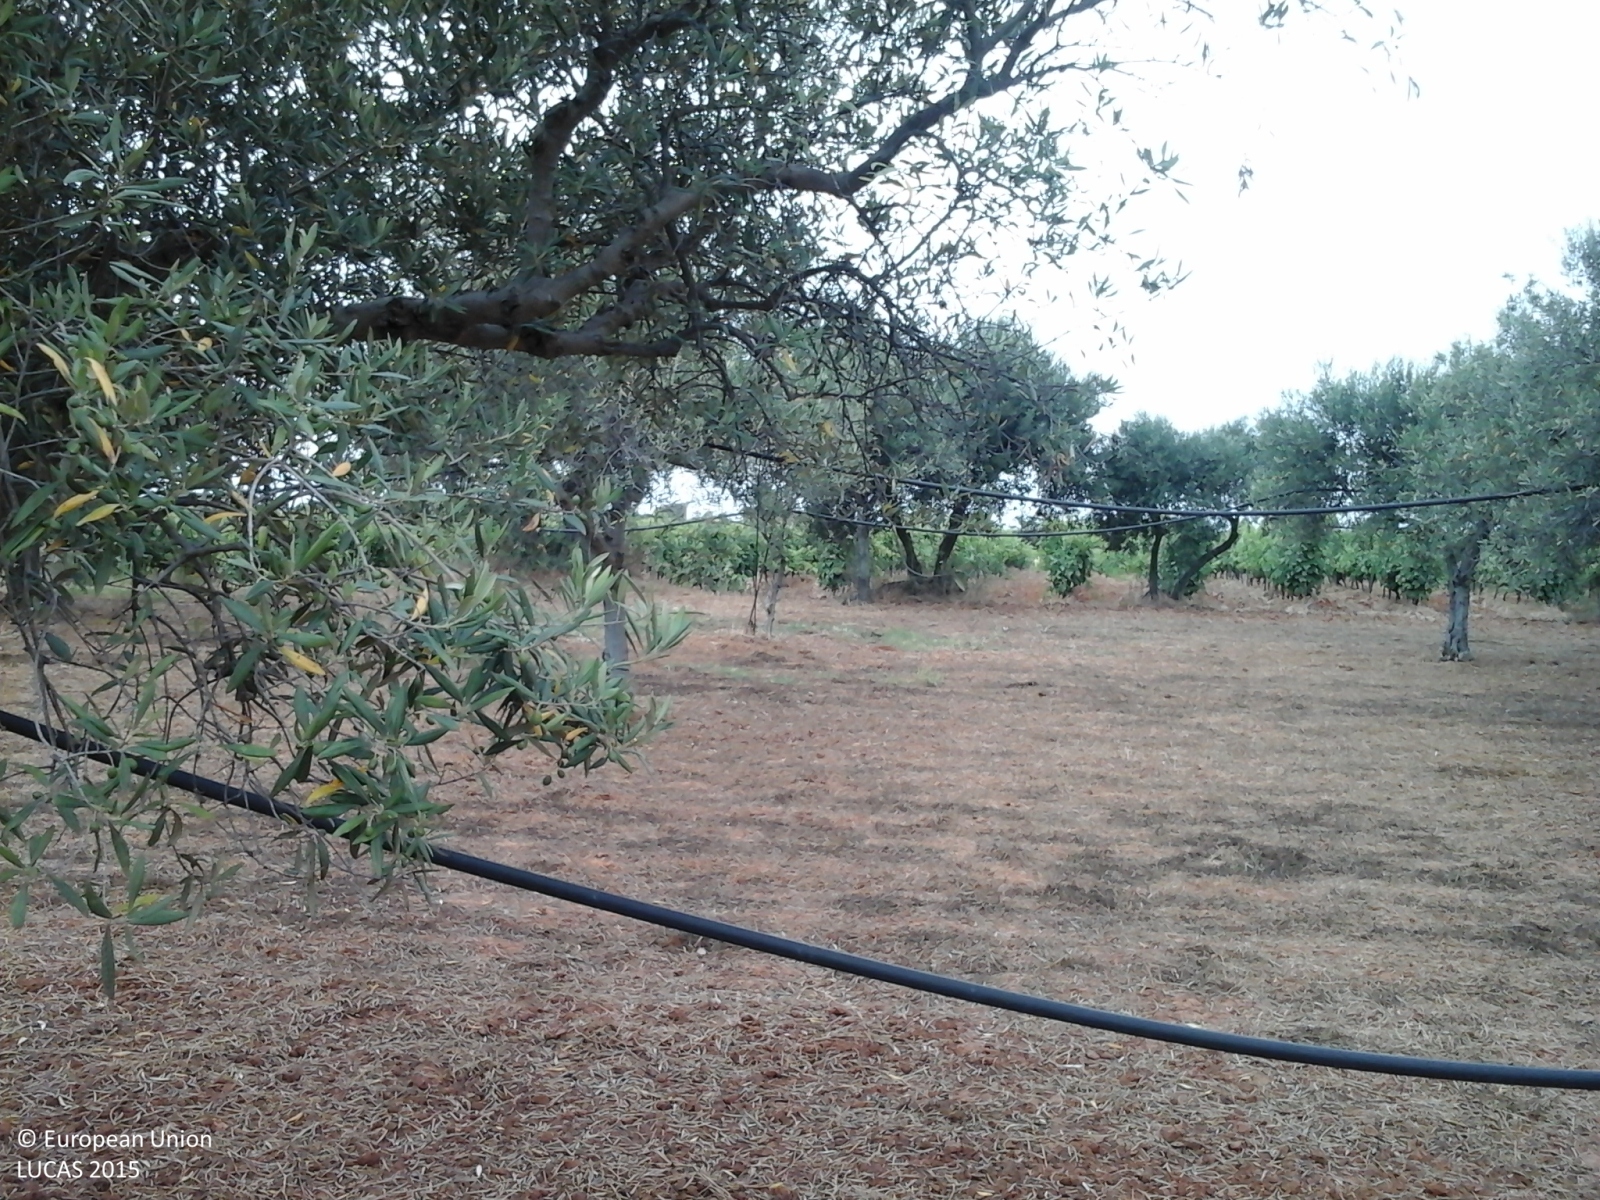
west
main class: Cropland
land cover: Olive groves
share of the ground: 50 - 75 %
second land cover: Other bare soil
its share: > 75 %
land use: Agriculture (excluding fallow land and kitchen gardens)
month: May
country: IT
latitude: 37.5361
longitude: 13.0211
